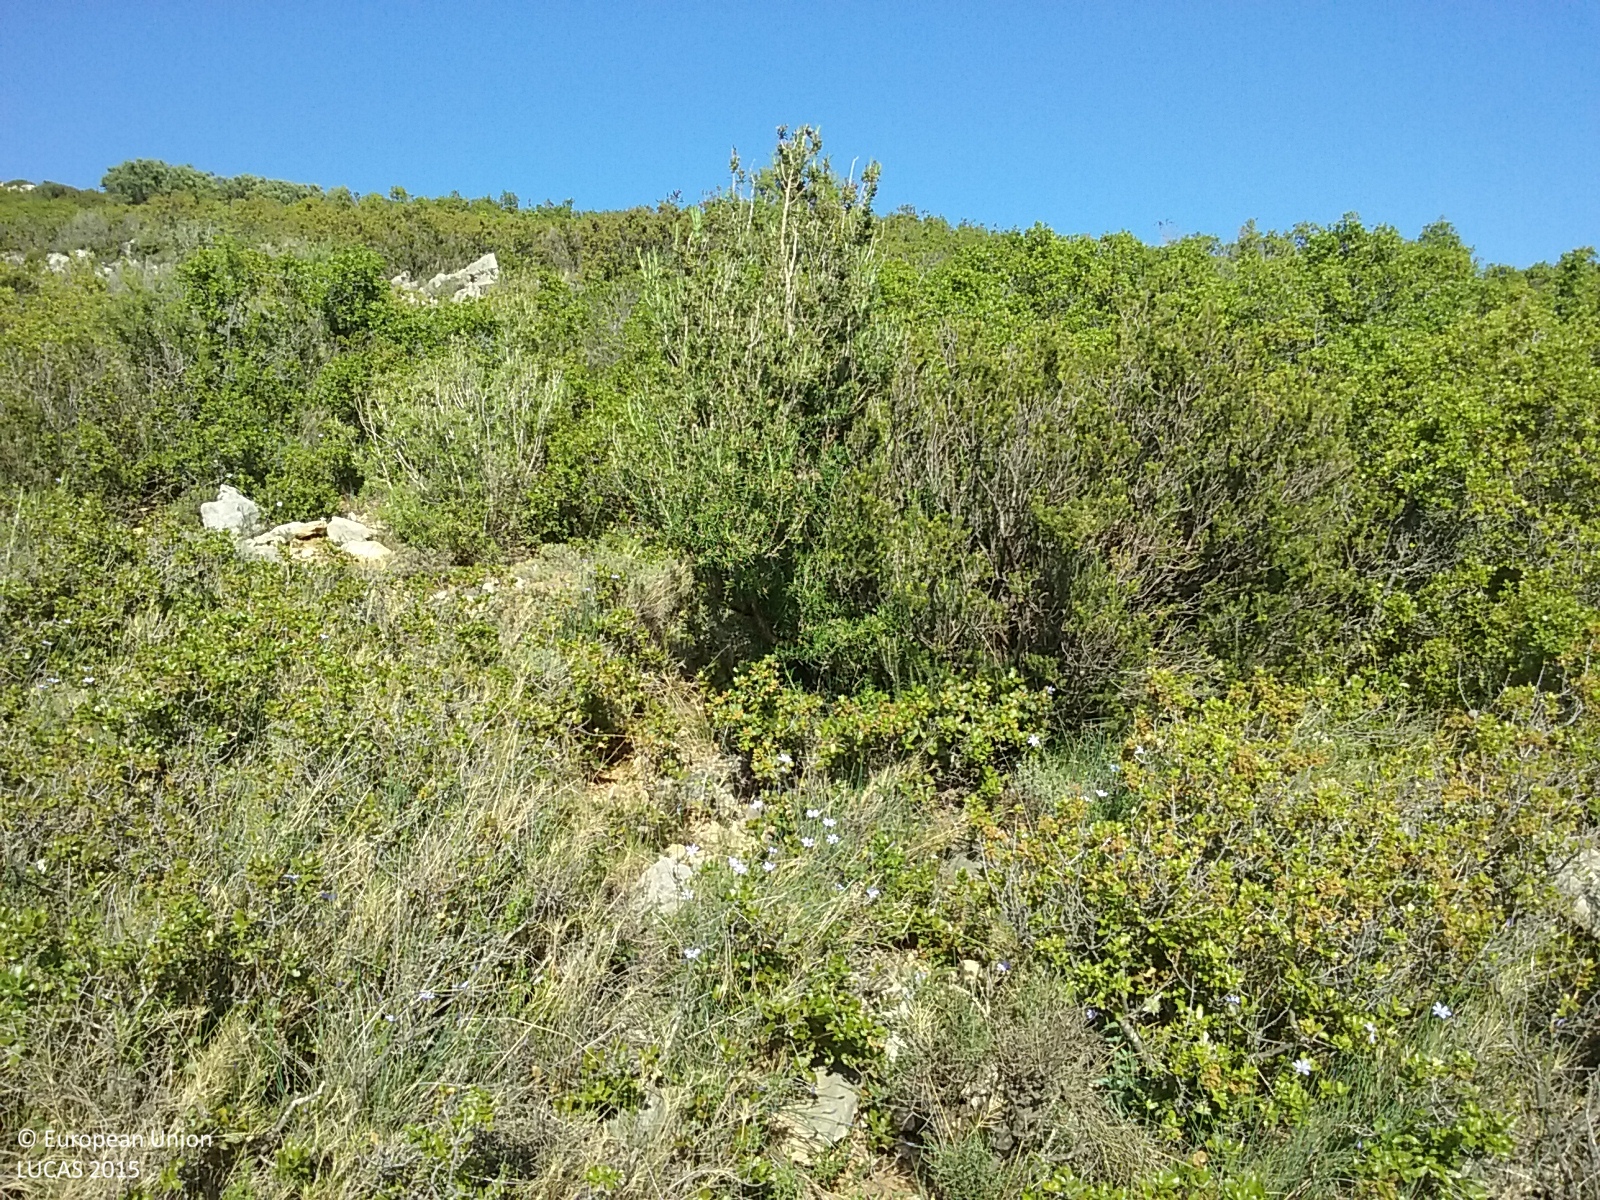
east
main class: Shrubland
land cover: Shrubland without tree cover
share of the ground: > 75 %
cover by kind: shrubs 95 %
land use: Semi-natural and natural areas not in use
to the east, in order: Shrubland without tree cover; Tracks; Shrubland without tree cover
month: May
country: ES
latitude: 40.6330
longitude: 0.2163
